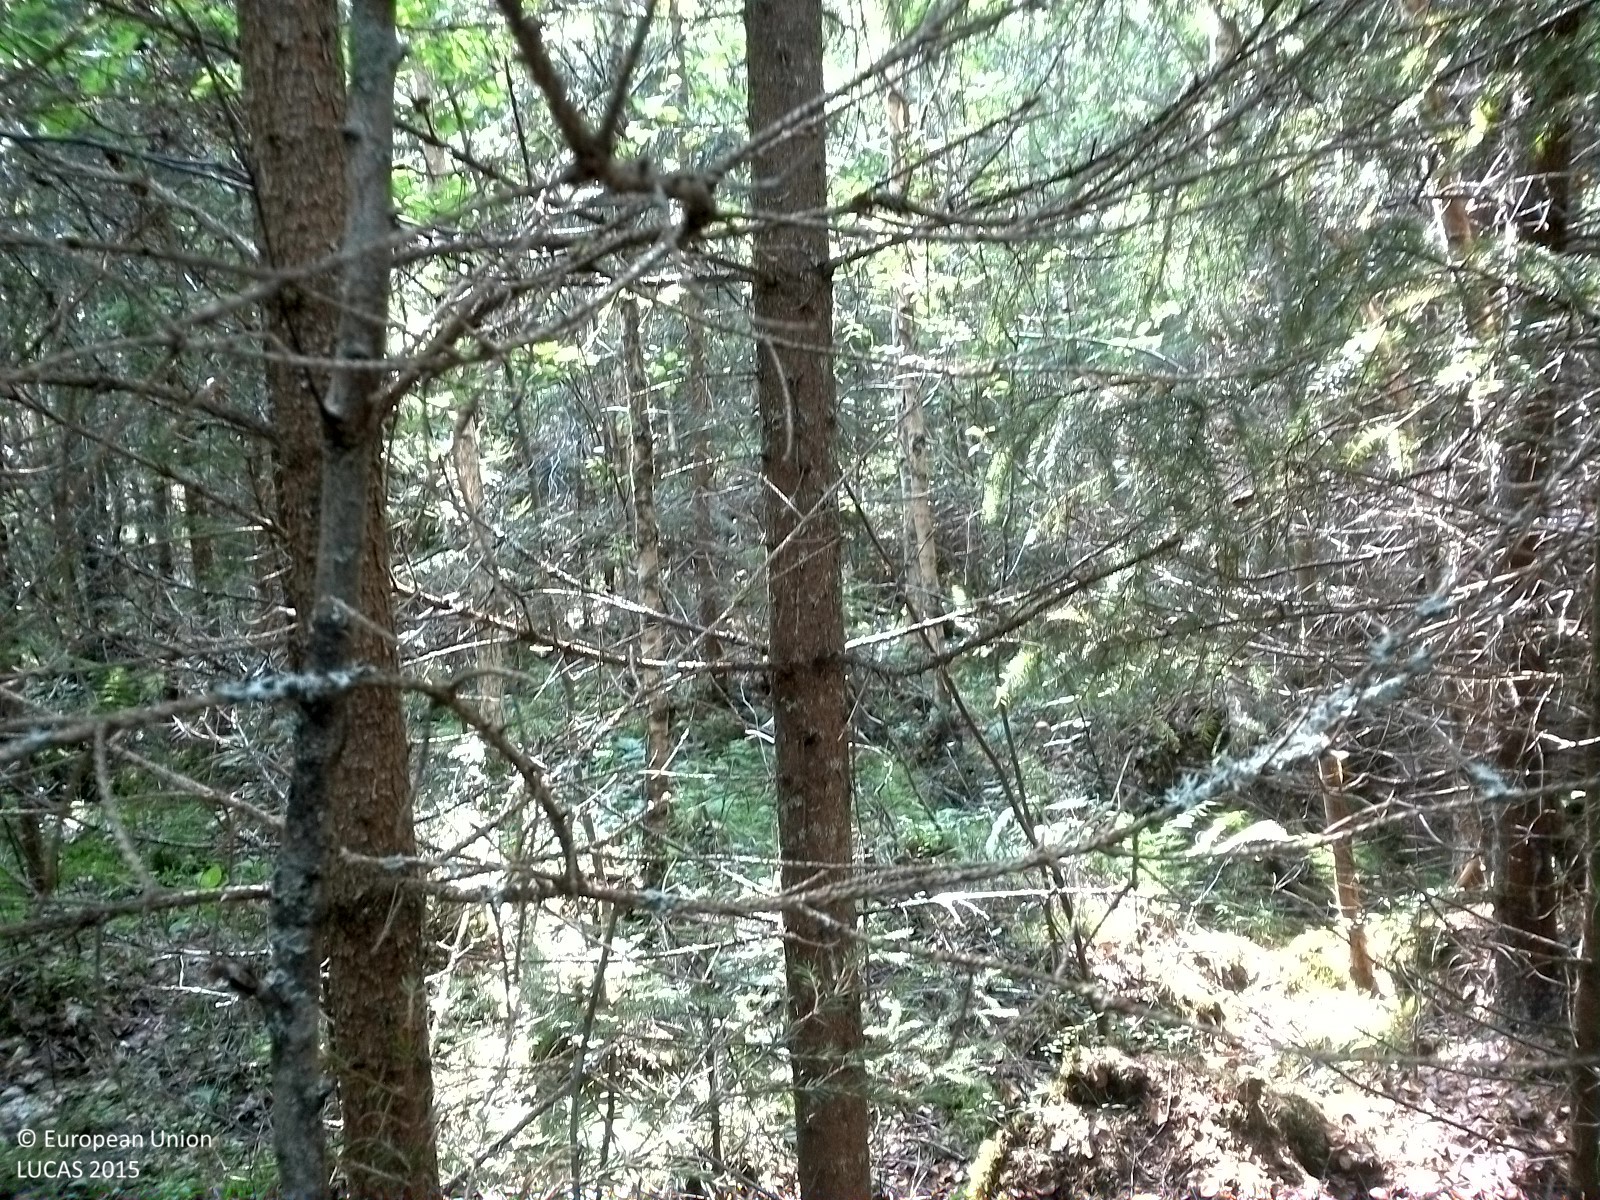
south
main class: Woodland
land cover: Spruce dominated mixed woodland
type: boreal forest
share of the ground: 50 - 75 %
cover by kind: coniferous forest trees 40 %, broadleaved forest trees 25 %, consolidated bare surface 20 %, lichens and mosses 10 %, herbaceous plants 5 %
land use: Forestry
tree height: < 5 m
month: August
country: SE
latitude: 59.0856
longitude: 15.3846
